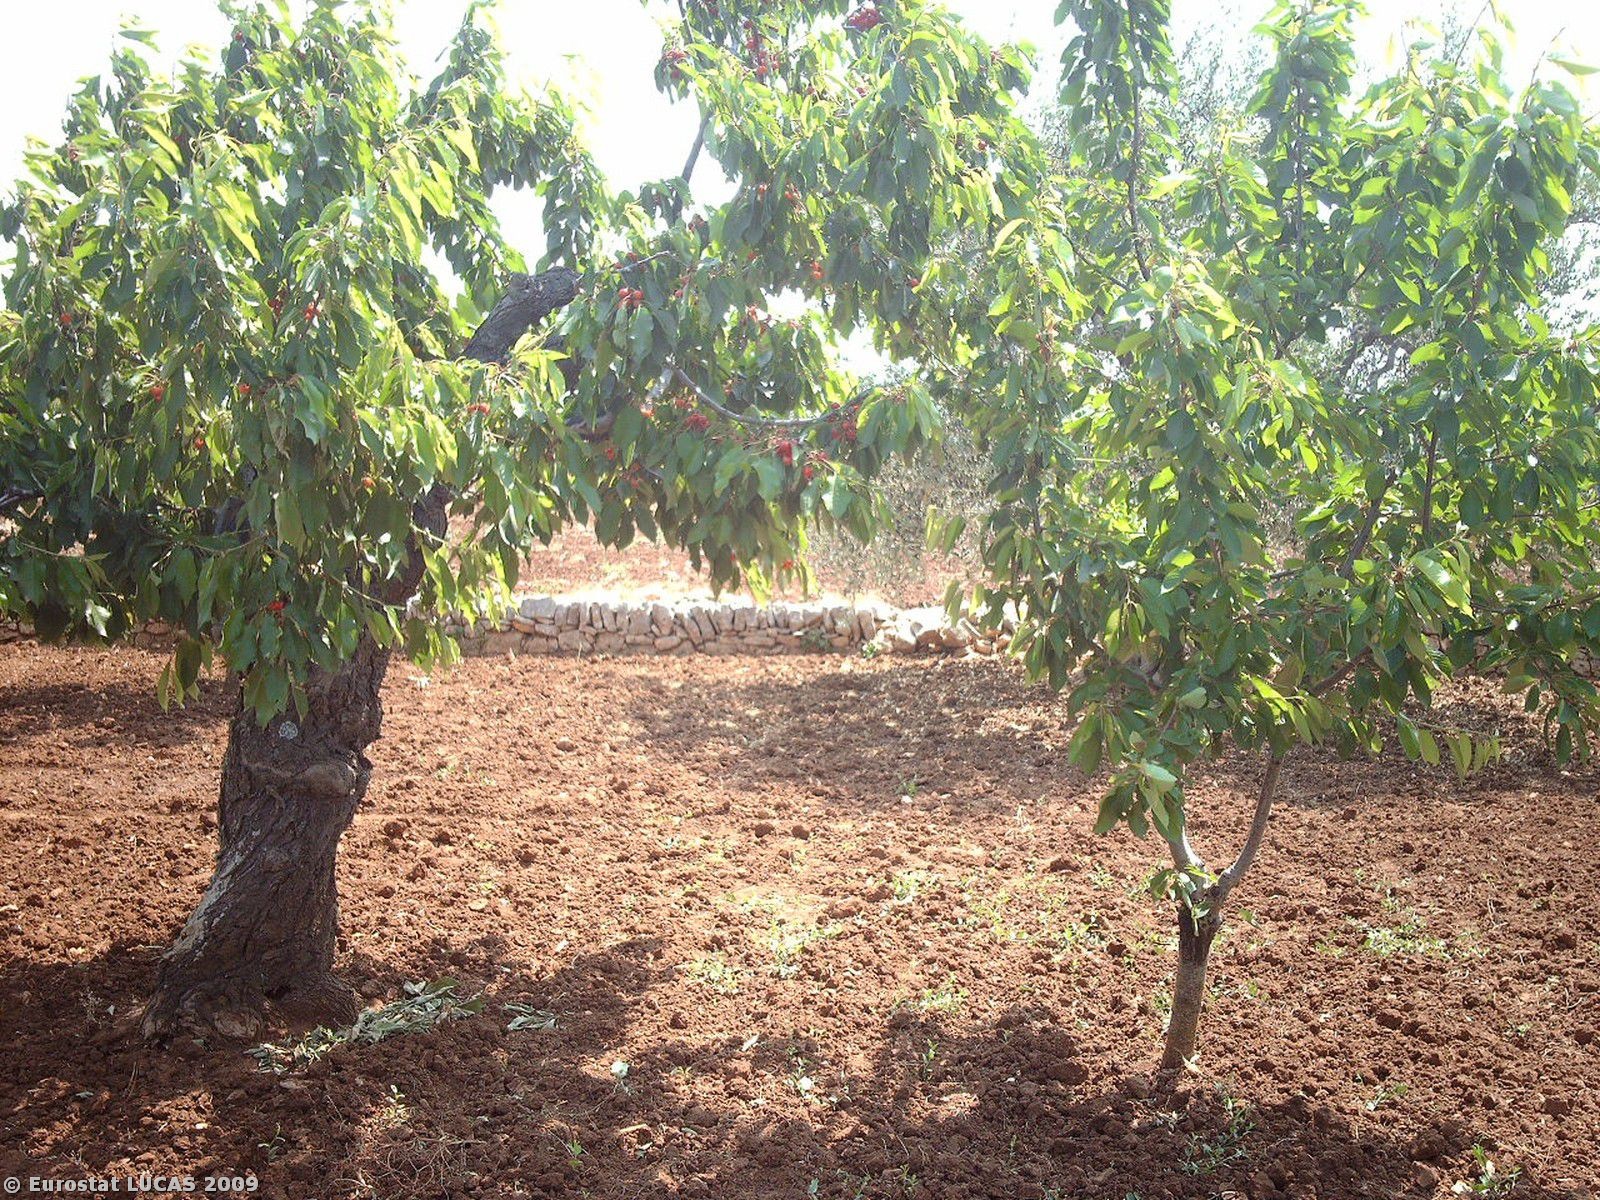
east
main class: Cropland
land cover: Cherry fruit
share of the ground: 50 - 75 %
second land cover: Olive groves
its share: 10 - 25 %
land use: Agriculture (excluding fallow land and kitchen gardens)
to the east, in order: Cherry fruit; Olive groves; Bare land; Dry stone walls; Cherry fruit; Bare land; Grass margins; Dry stone walls; Cherry fruit; Mixed cereals for fodder; Bare land
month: May
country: IT
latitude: 40.9070
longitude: 16.9944
